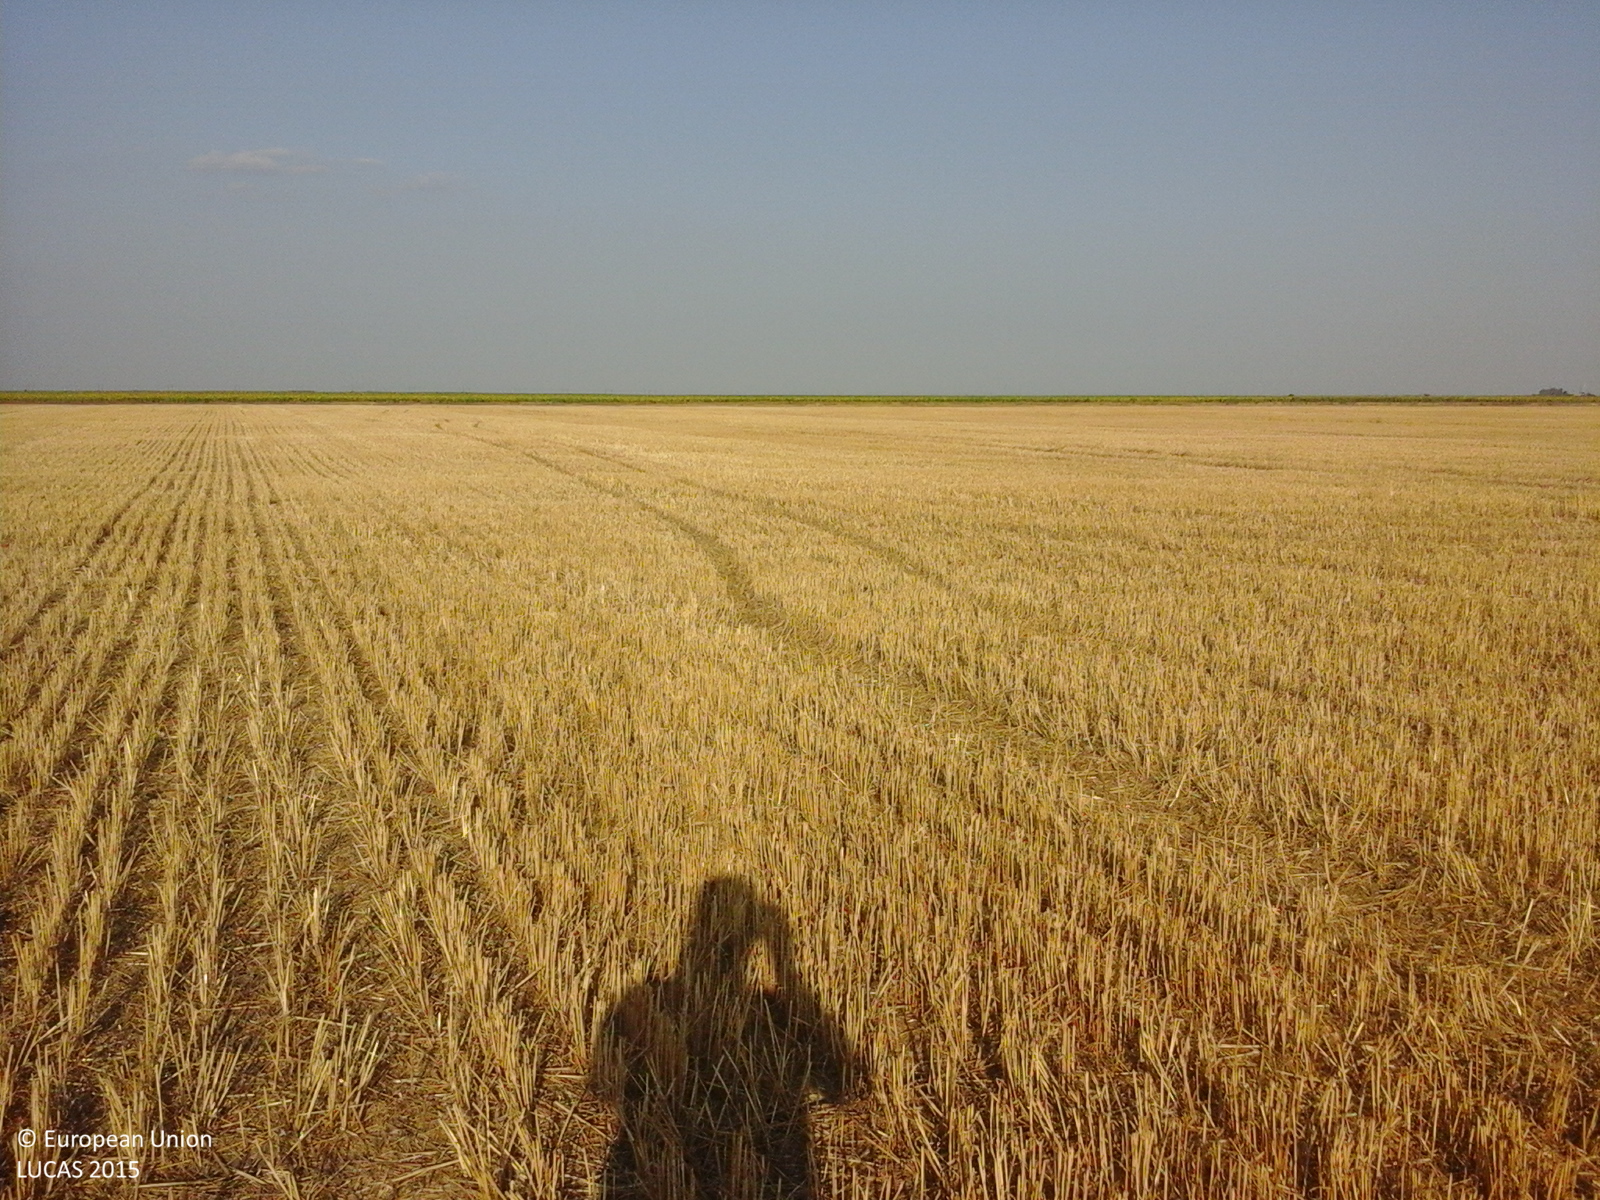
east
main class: Cropland
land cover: Common wheat
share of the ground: < 10 %
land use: Agriculture (excluding fallow land and kitchen gardens)
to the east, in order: Common wheat
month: July
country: RO
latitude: 44.9960
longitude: 27.3316
